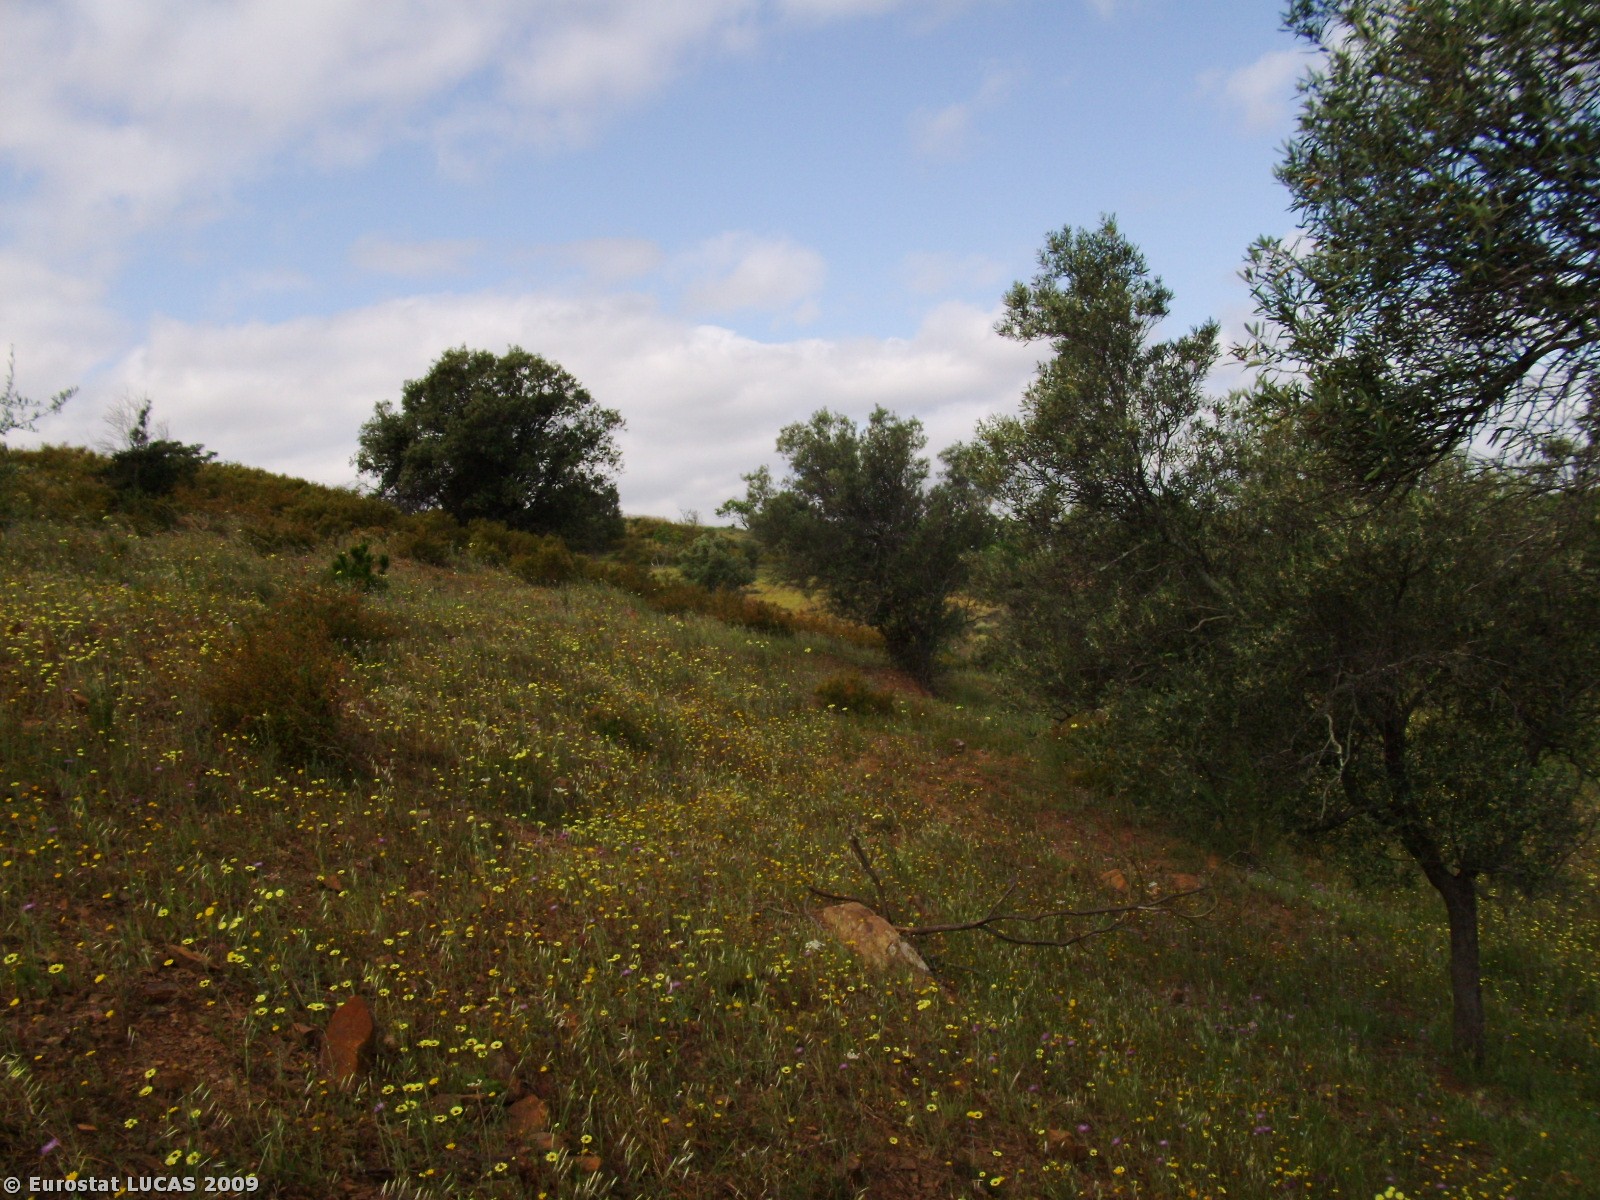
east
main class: Cropland
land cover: Olive groves
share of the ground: < 10 %
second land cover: Spontaneously vegetated surfaces
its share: > 75 %
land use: Agriculture (excluding fallow land and kitchen gardens)
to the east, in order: Olive groves; Spontaneously vegetated surfaces; Ditches and canals; Shrubland with sparse tree cover; Dry stone walls; Spontaneously vegetated surfaces; Dry stone walls; Artificial constructions in urban areas; Spontaneously vegetated surfaces; Fences; Spontaneously vegetated surfaces
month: April
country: PT
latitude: 37.1981
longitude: -7.5226
